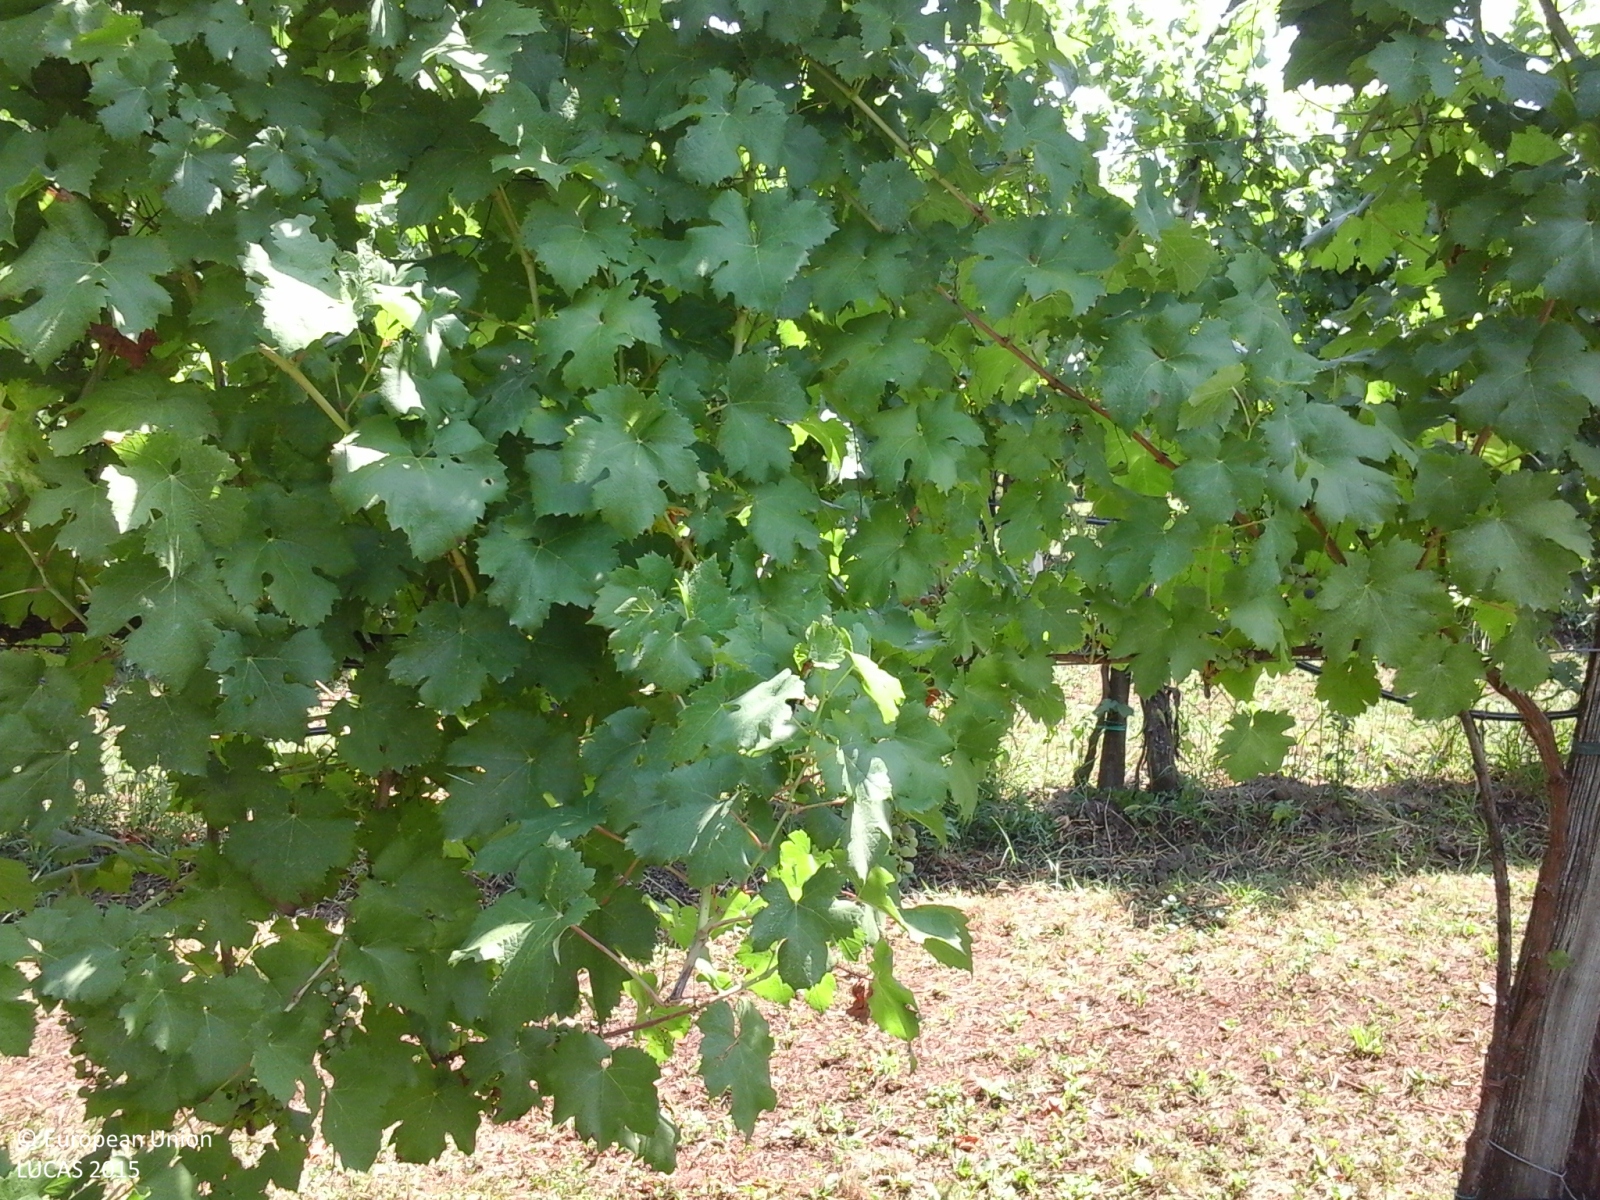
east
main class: Cropland
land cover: Vineyards
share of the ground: 50 - 75 %
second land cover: Grassland without tree/shrub cover
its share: > 75 %
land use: Agriculture (excluding fallow land and kitchen gardens)
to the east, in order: Vineyards; Grassland without tree/shrub cover; Abandoned hedges; Ditches and canals; Grassland without tree/shrub cover; Abandoned hedges; Ditches and canals; Grassland without tree/shrub cover; Abandoned hedges; Ditches and canals; Vineyards; Ditches and canals; Vineyards; Ditches and canals; Common wheat
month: June
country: IT
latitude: 45.7092
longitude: 12.5013
